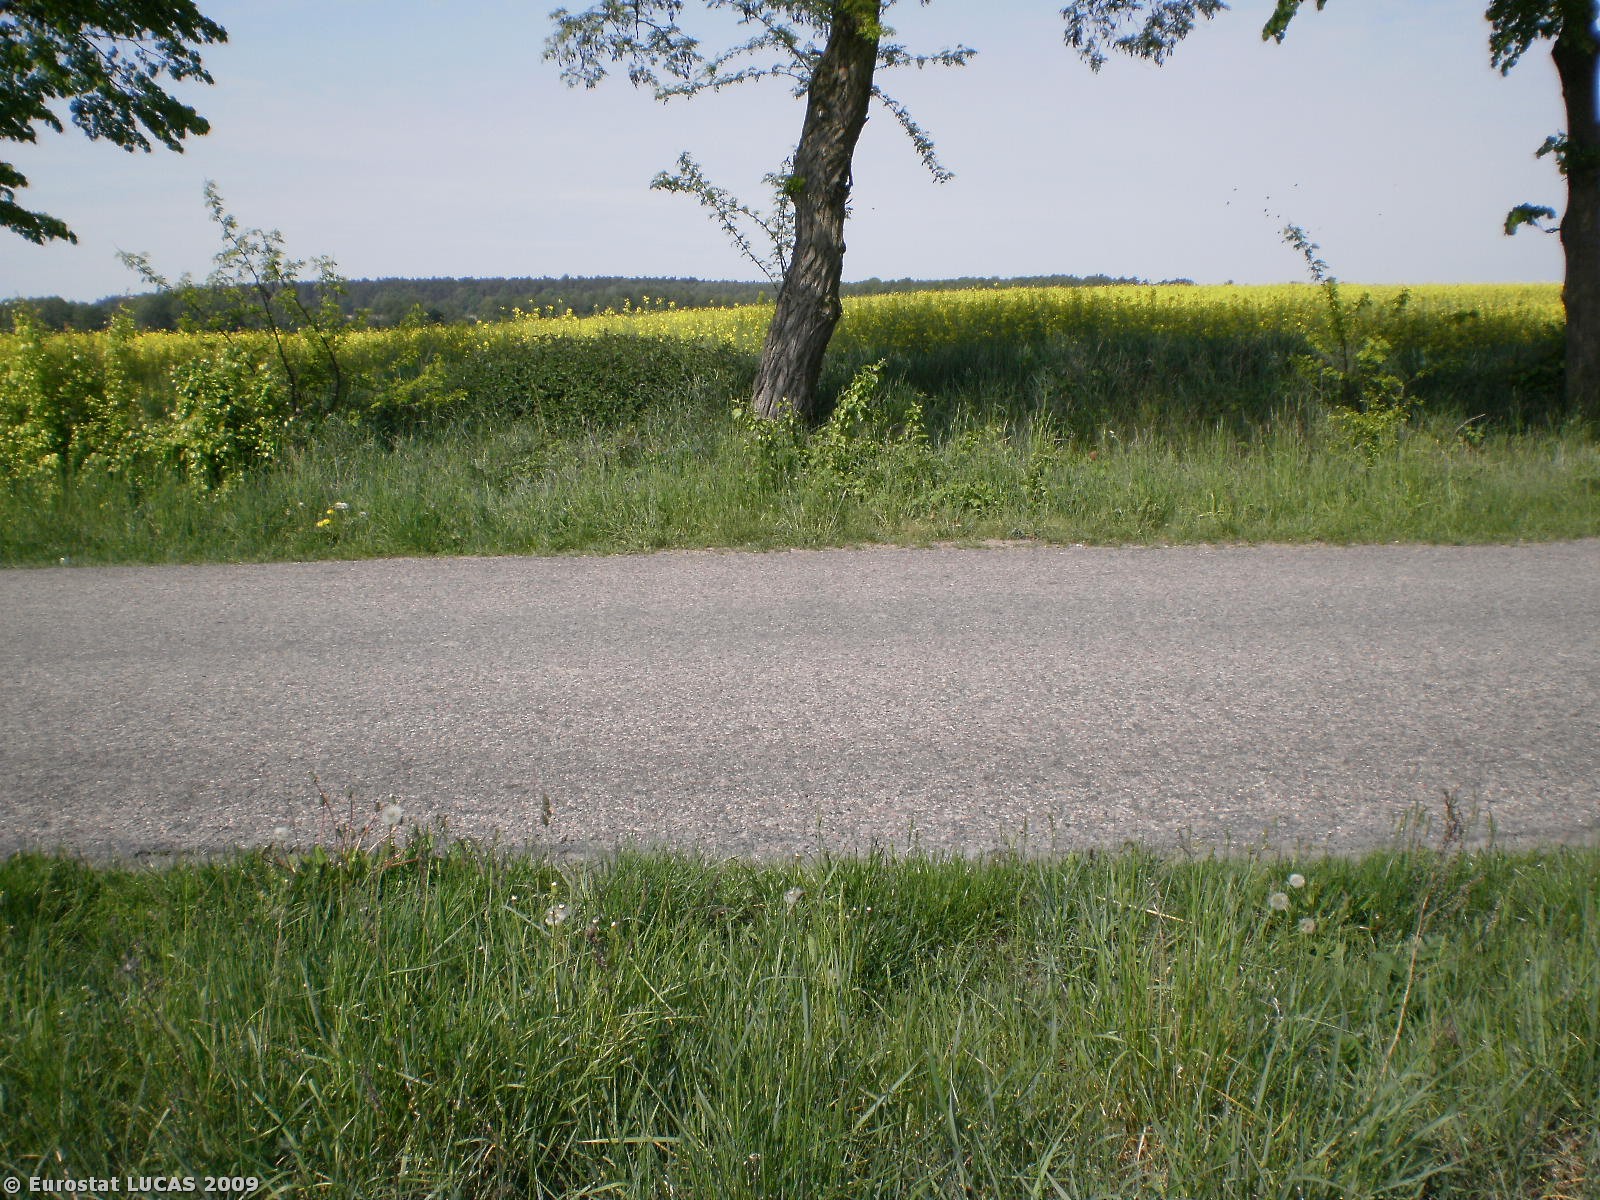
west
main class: Cropland
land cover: Rape and turnip rape
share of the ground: > 75 %
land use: Agriculture (excluding fallow land and kitchen gardens)
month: May
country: PL
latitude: 53.3662
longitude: 18.0856
